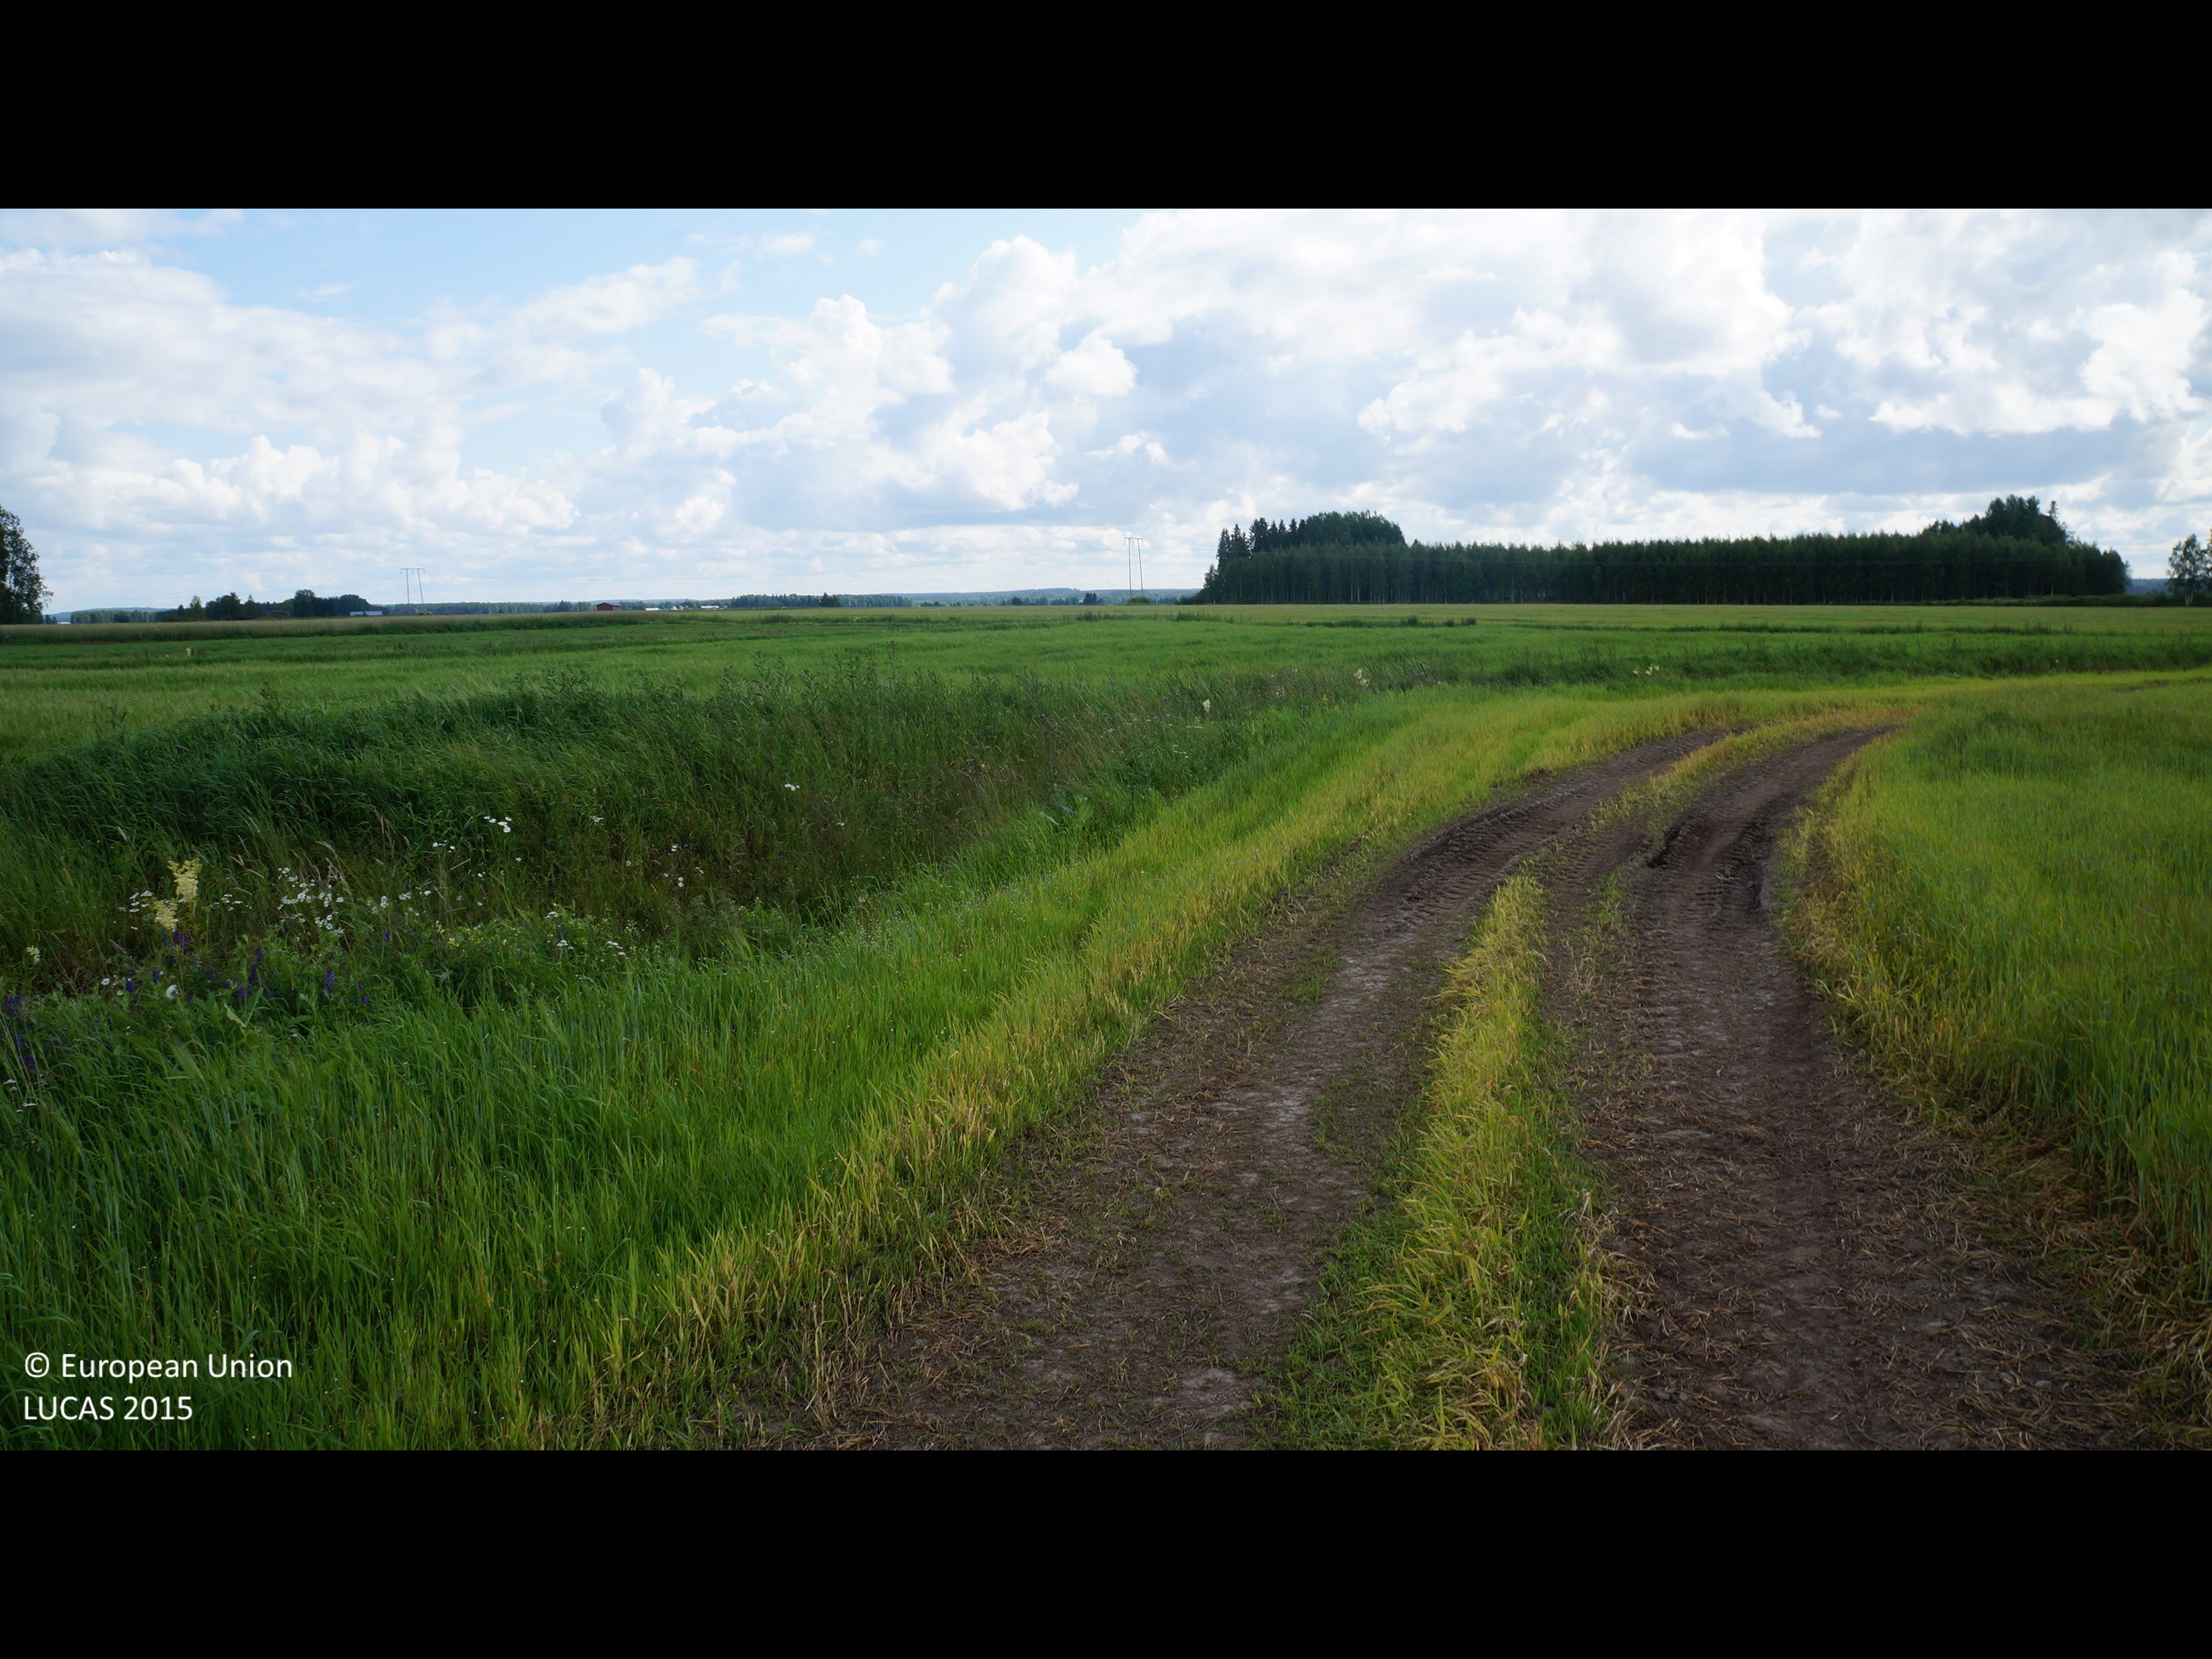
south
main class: Cropland
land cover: Barley
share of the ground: > 75 %
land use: Agriculture (excluding fallow land and kitchen gardens)
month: July
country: FI
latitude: 63.8562
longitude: 25.0797
